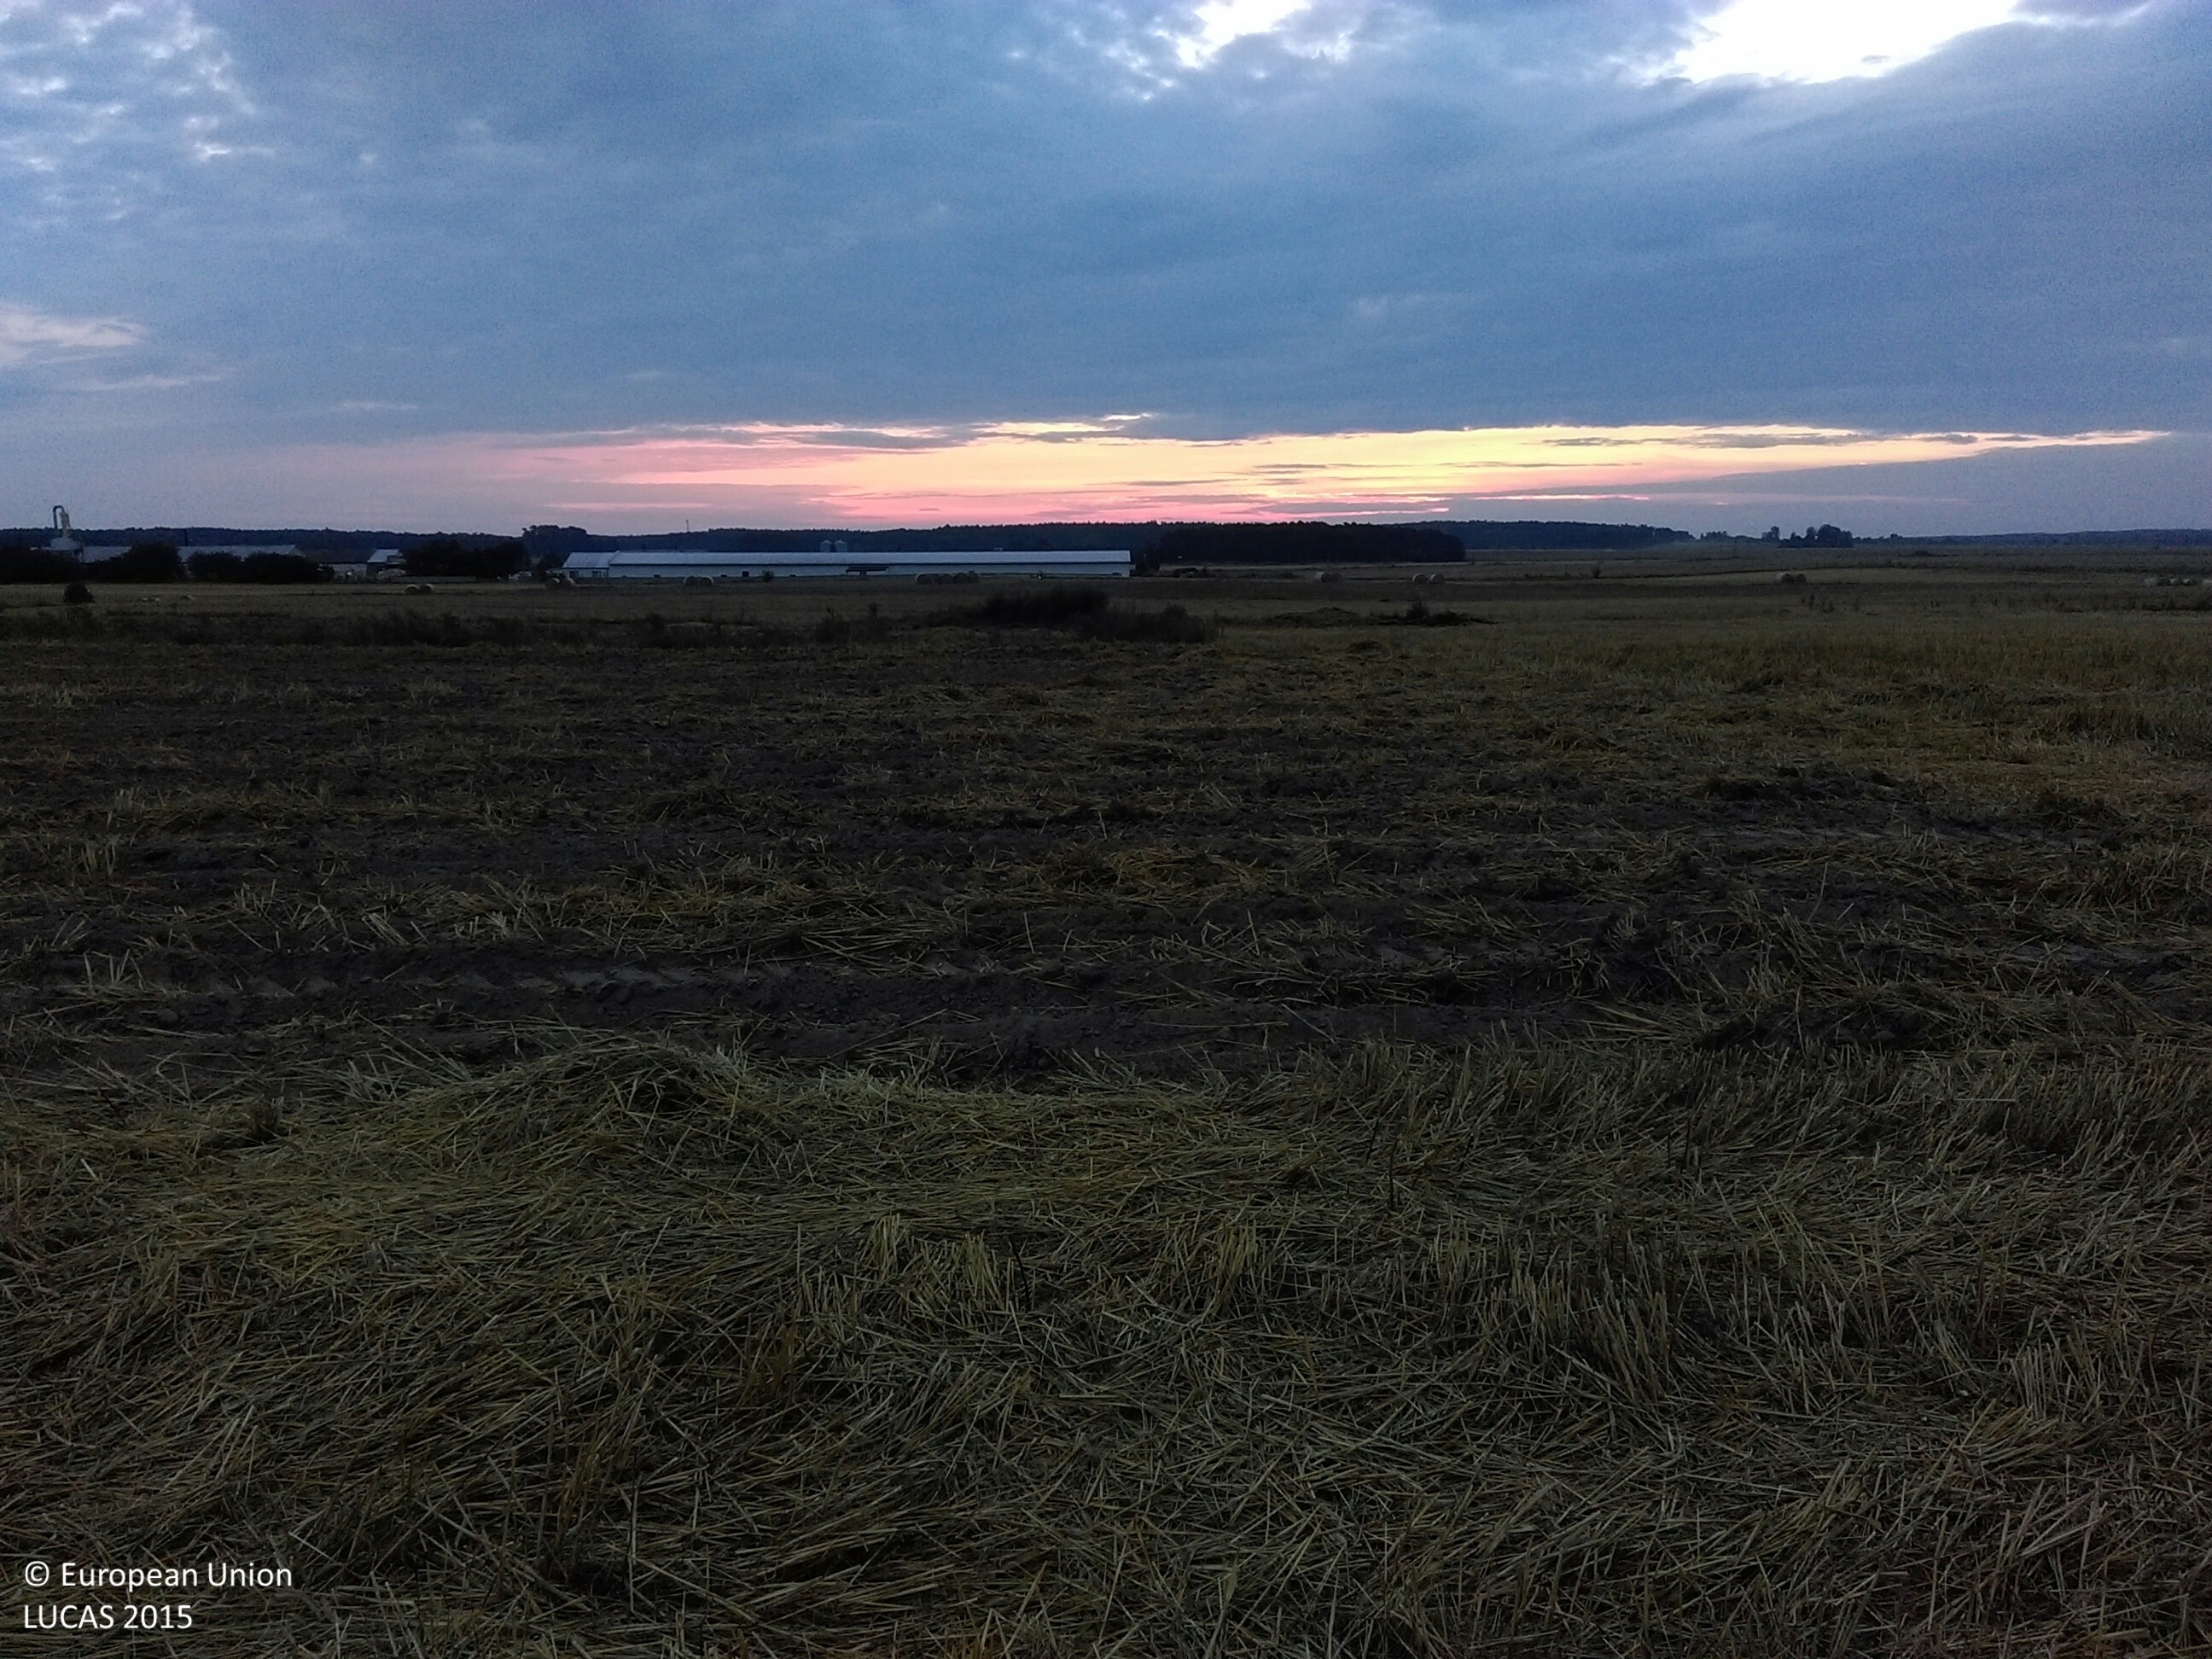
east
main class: Cropland
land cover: Rye
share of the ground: > 75 %
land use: Agriculture (excluding fallow land and kitchen gardens)
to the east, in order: Rye; Common wheat; Rye; Tracks; Barley; Common wheat
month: August
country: PL
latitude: 52.1193
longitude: 15.5980
